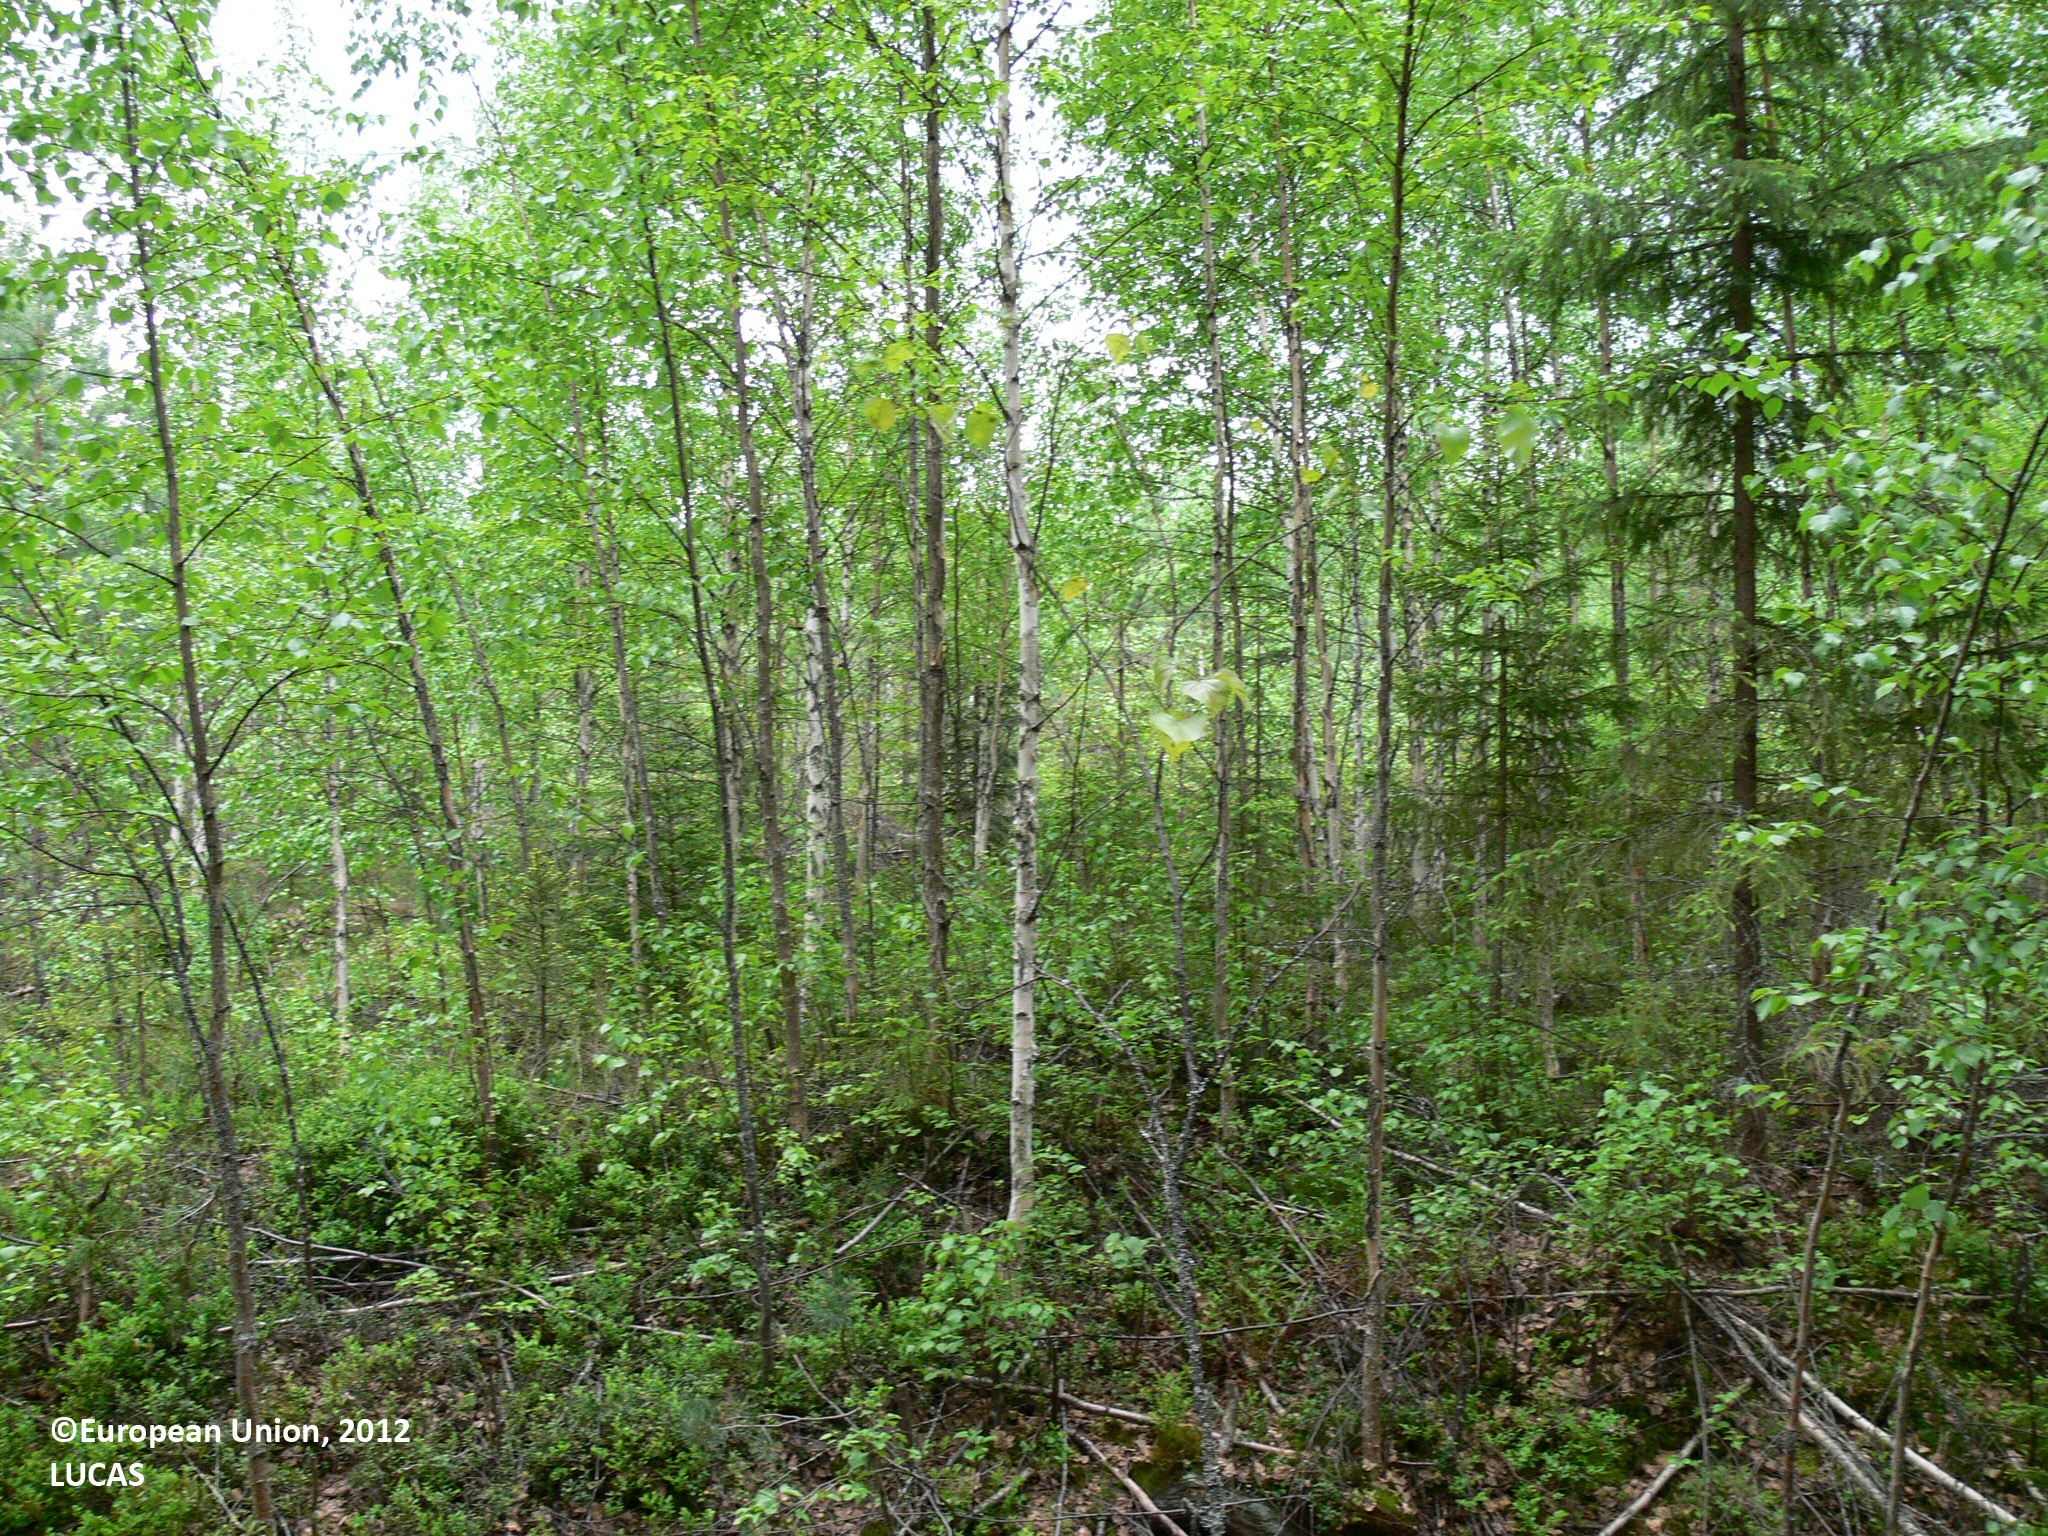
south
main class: Woodland
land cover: Other mixed woodland
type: boreal forest
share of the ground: > 75 %
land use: Forestry
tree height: > 5 m
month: June
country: FI
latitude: 62.6141
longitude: 30.4070
